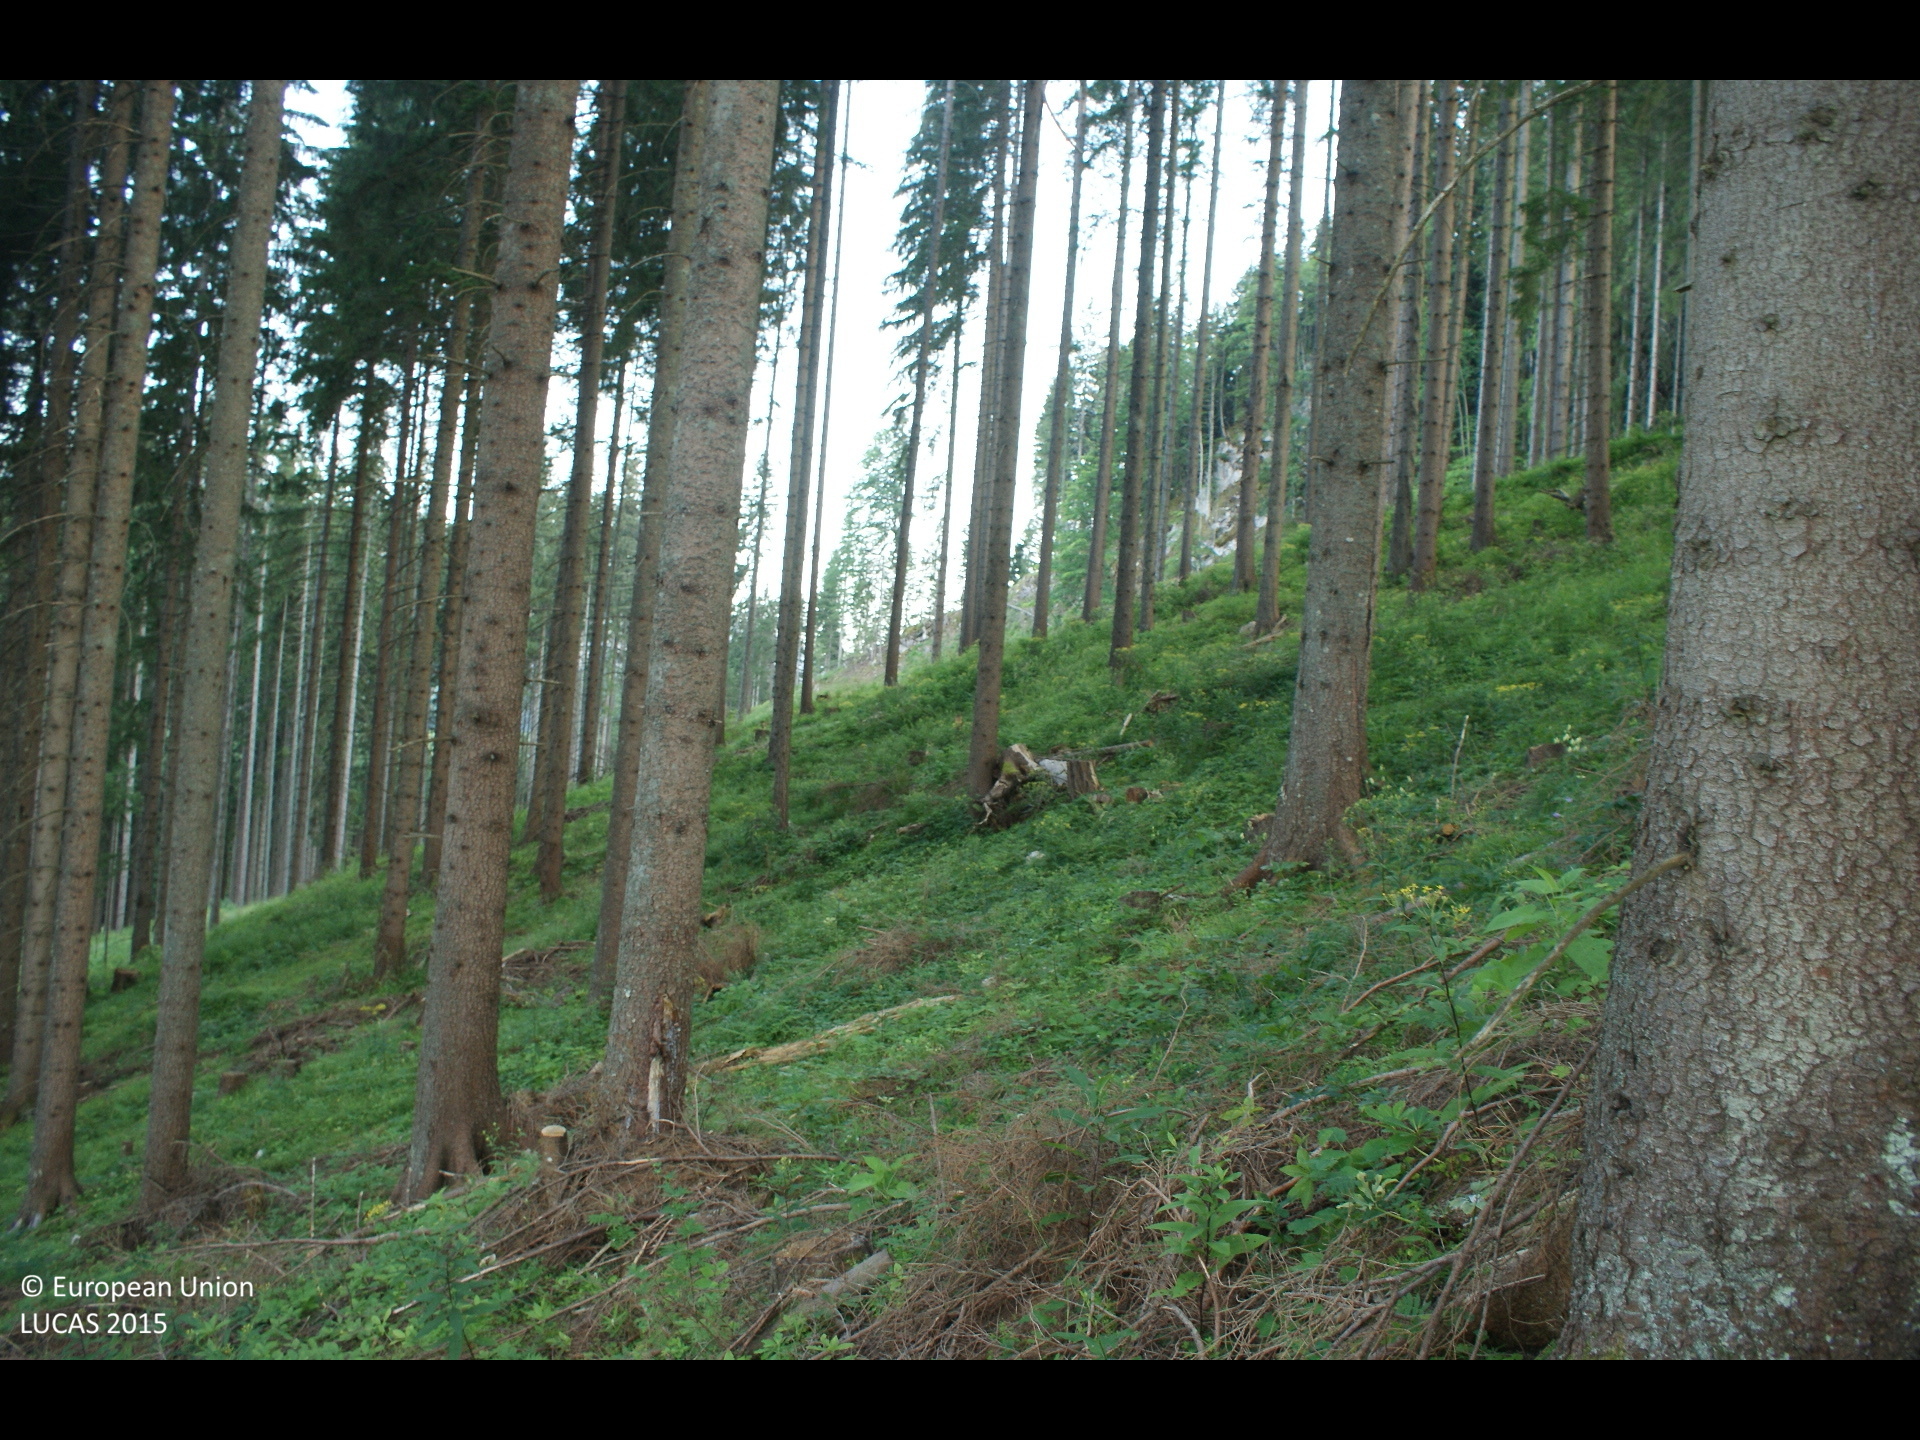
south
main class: Woodland
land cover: Spruce dominated coniferous woodland
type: alpine coniferous forest
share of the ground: 50 - 75 %
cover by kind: coniferous forest trees 70 %, herbaceous plants 30 %
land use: Forestry
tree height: > 5 m
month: July
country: AT
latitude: 47.7510
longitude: 15.3499
